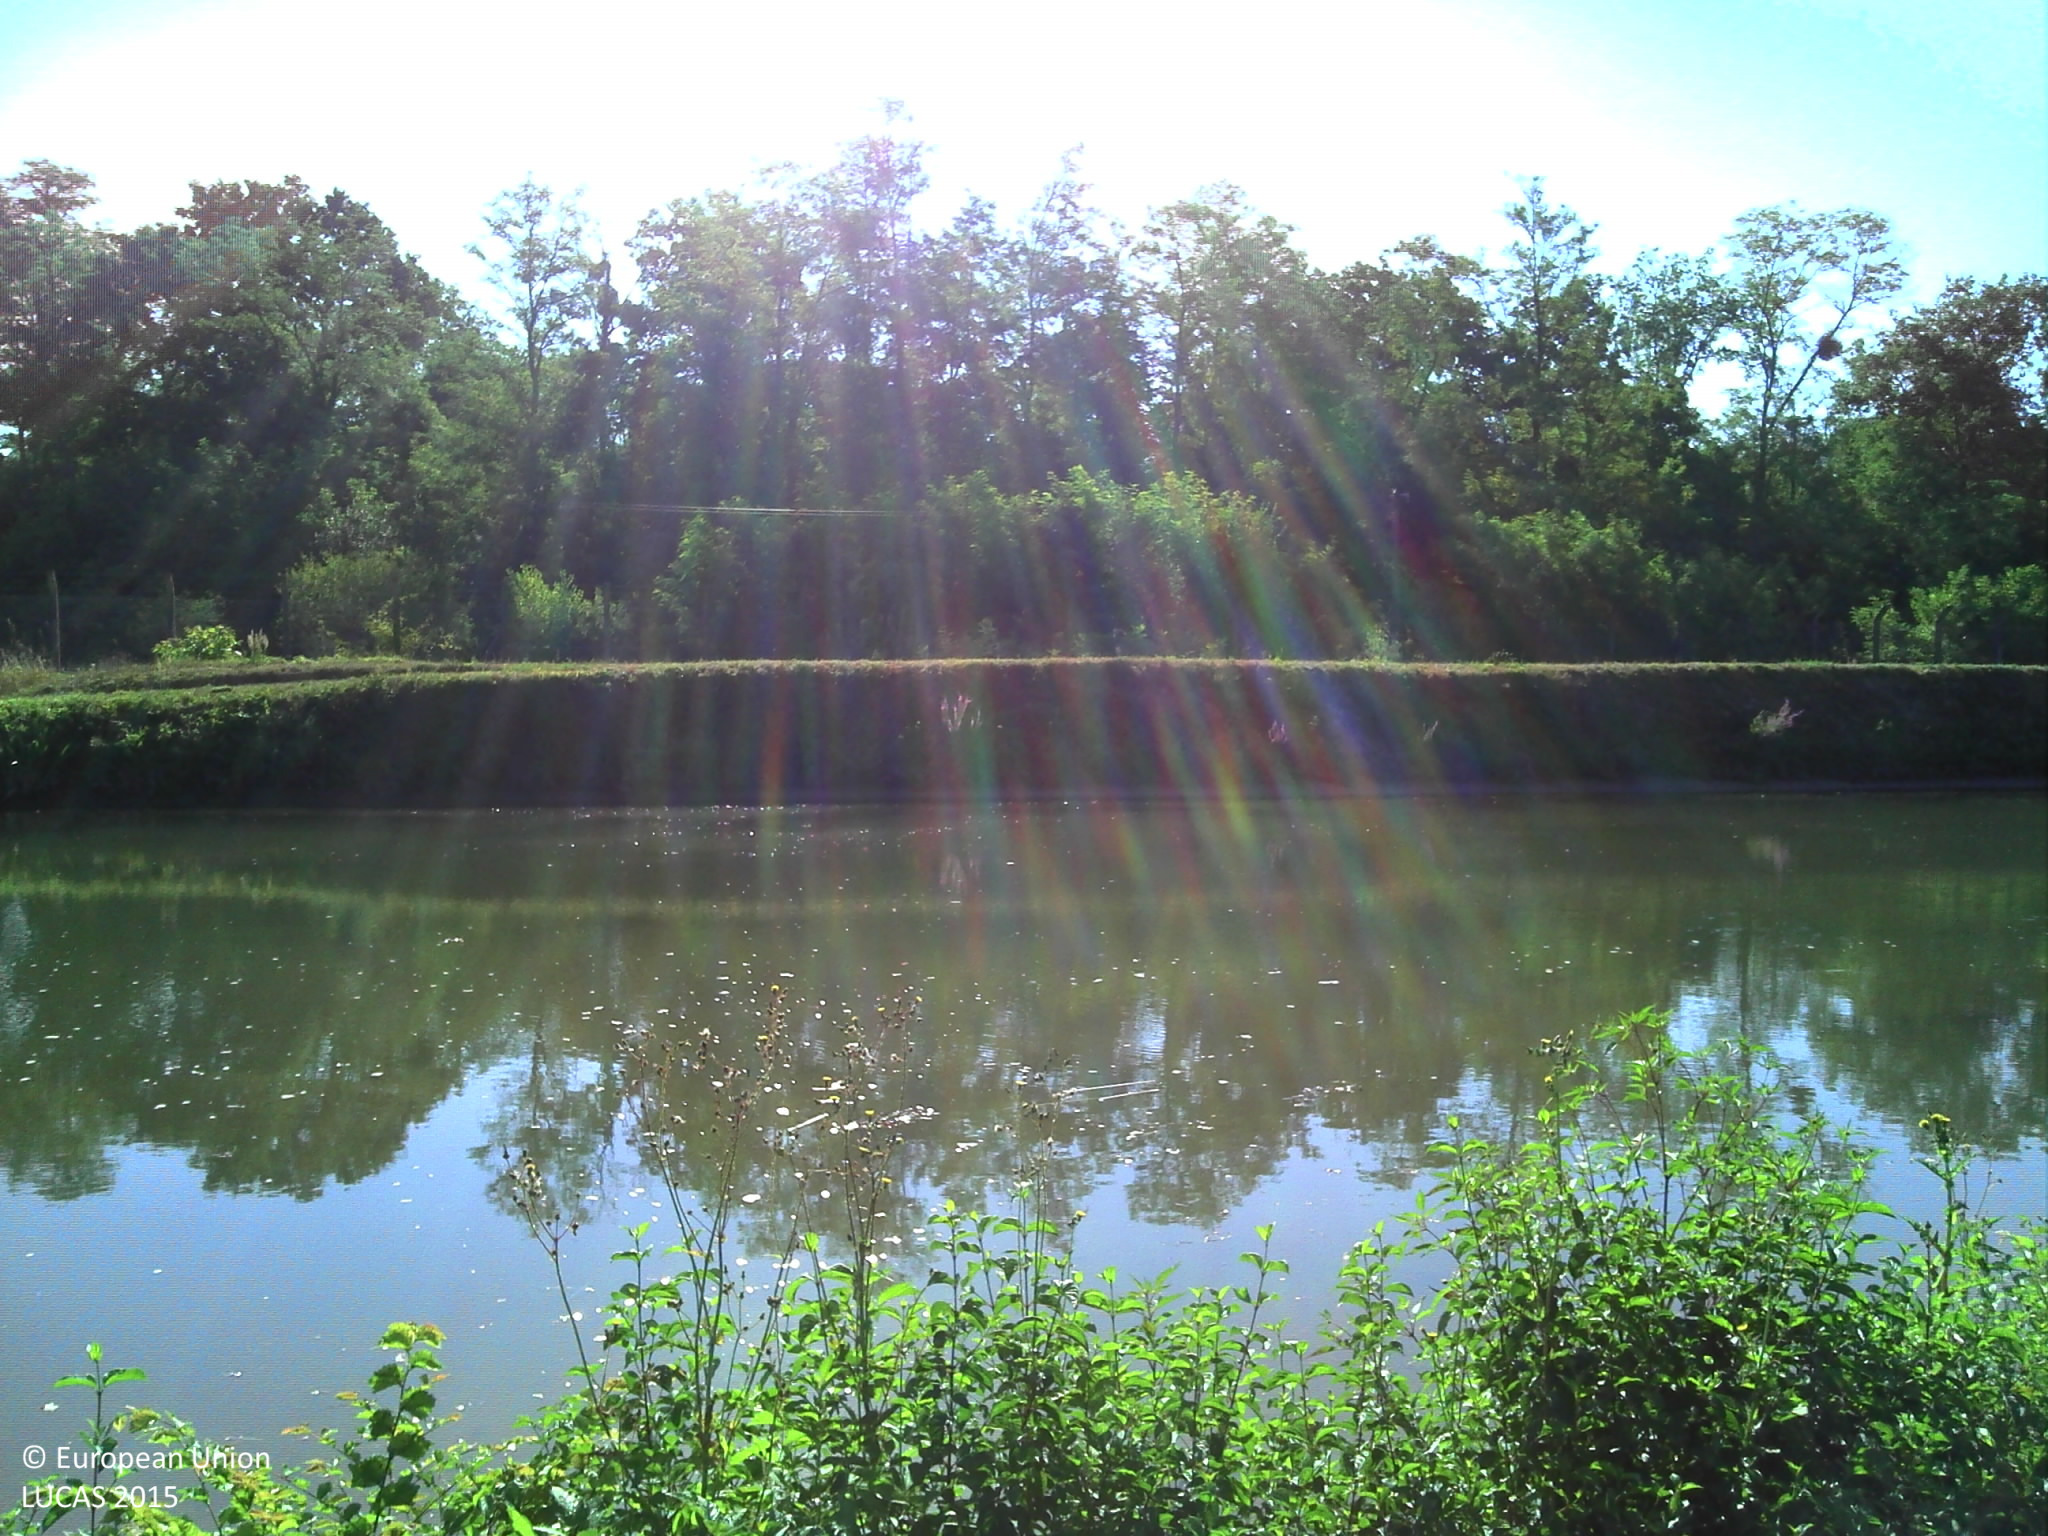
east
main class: Shrubland
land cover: Shrubland with sparse tree cover
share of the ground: > 75 %
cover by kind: herbaceous plants 65 %, shrubs 30 %, broadleaved forest trees 5 %
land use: Semi-natural and natural areas not in use
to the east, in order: Shrubland with sparse tree cover; Inland fresh running water; Grass margins; Paved roads, cycling and walking lanes; Electric lines; Grass margins; Shrubland with sparse tree cover; Fences; Grassland with sparse tree/shrub cover; Paved roads, cycling and walking lanes; Groves; Broadleaved woodland; Grassland without tree/shrub cover; Broadleaved woodland
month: August
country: FR
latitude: 47.9073
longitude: 3.5334
